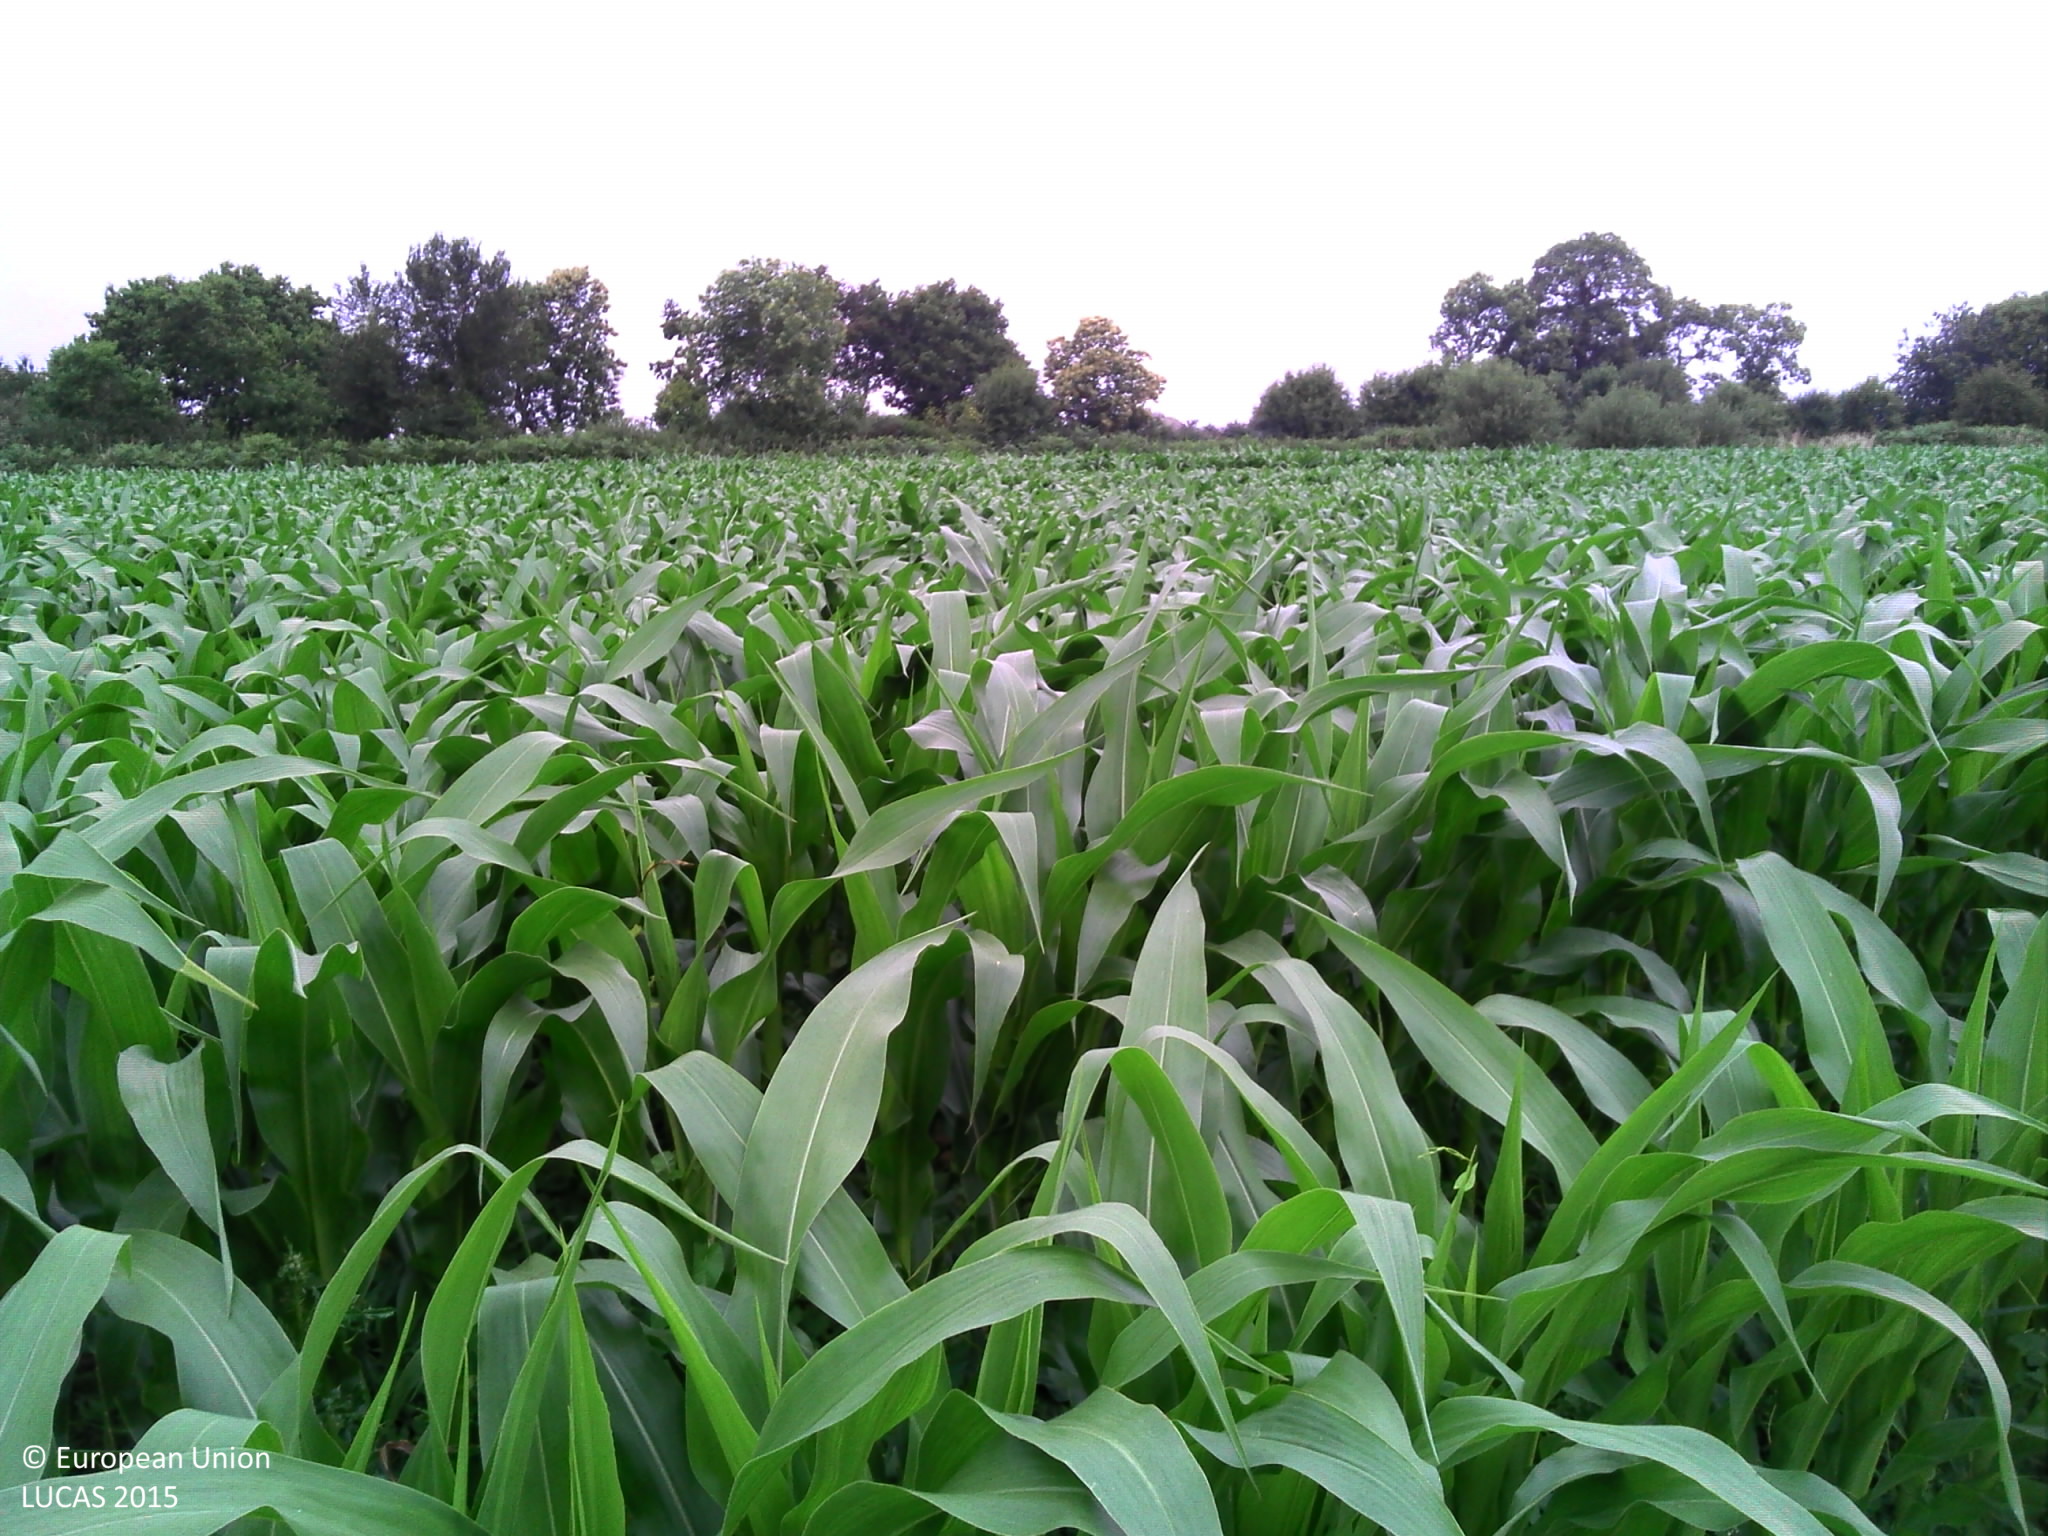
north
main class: Grassland
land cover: Grassland without tree/shrub cover
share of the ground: > 75 %
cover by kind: herbaceous plants 80 %, lichens and mosses 10 %, unconsolidated bare surface 10 %
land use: Agriculture (excluding fallow land and kitchen gardens)
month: July
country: FR
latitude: 48.5871
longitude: -2.3008
